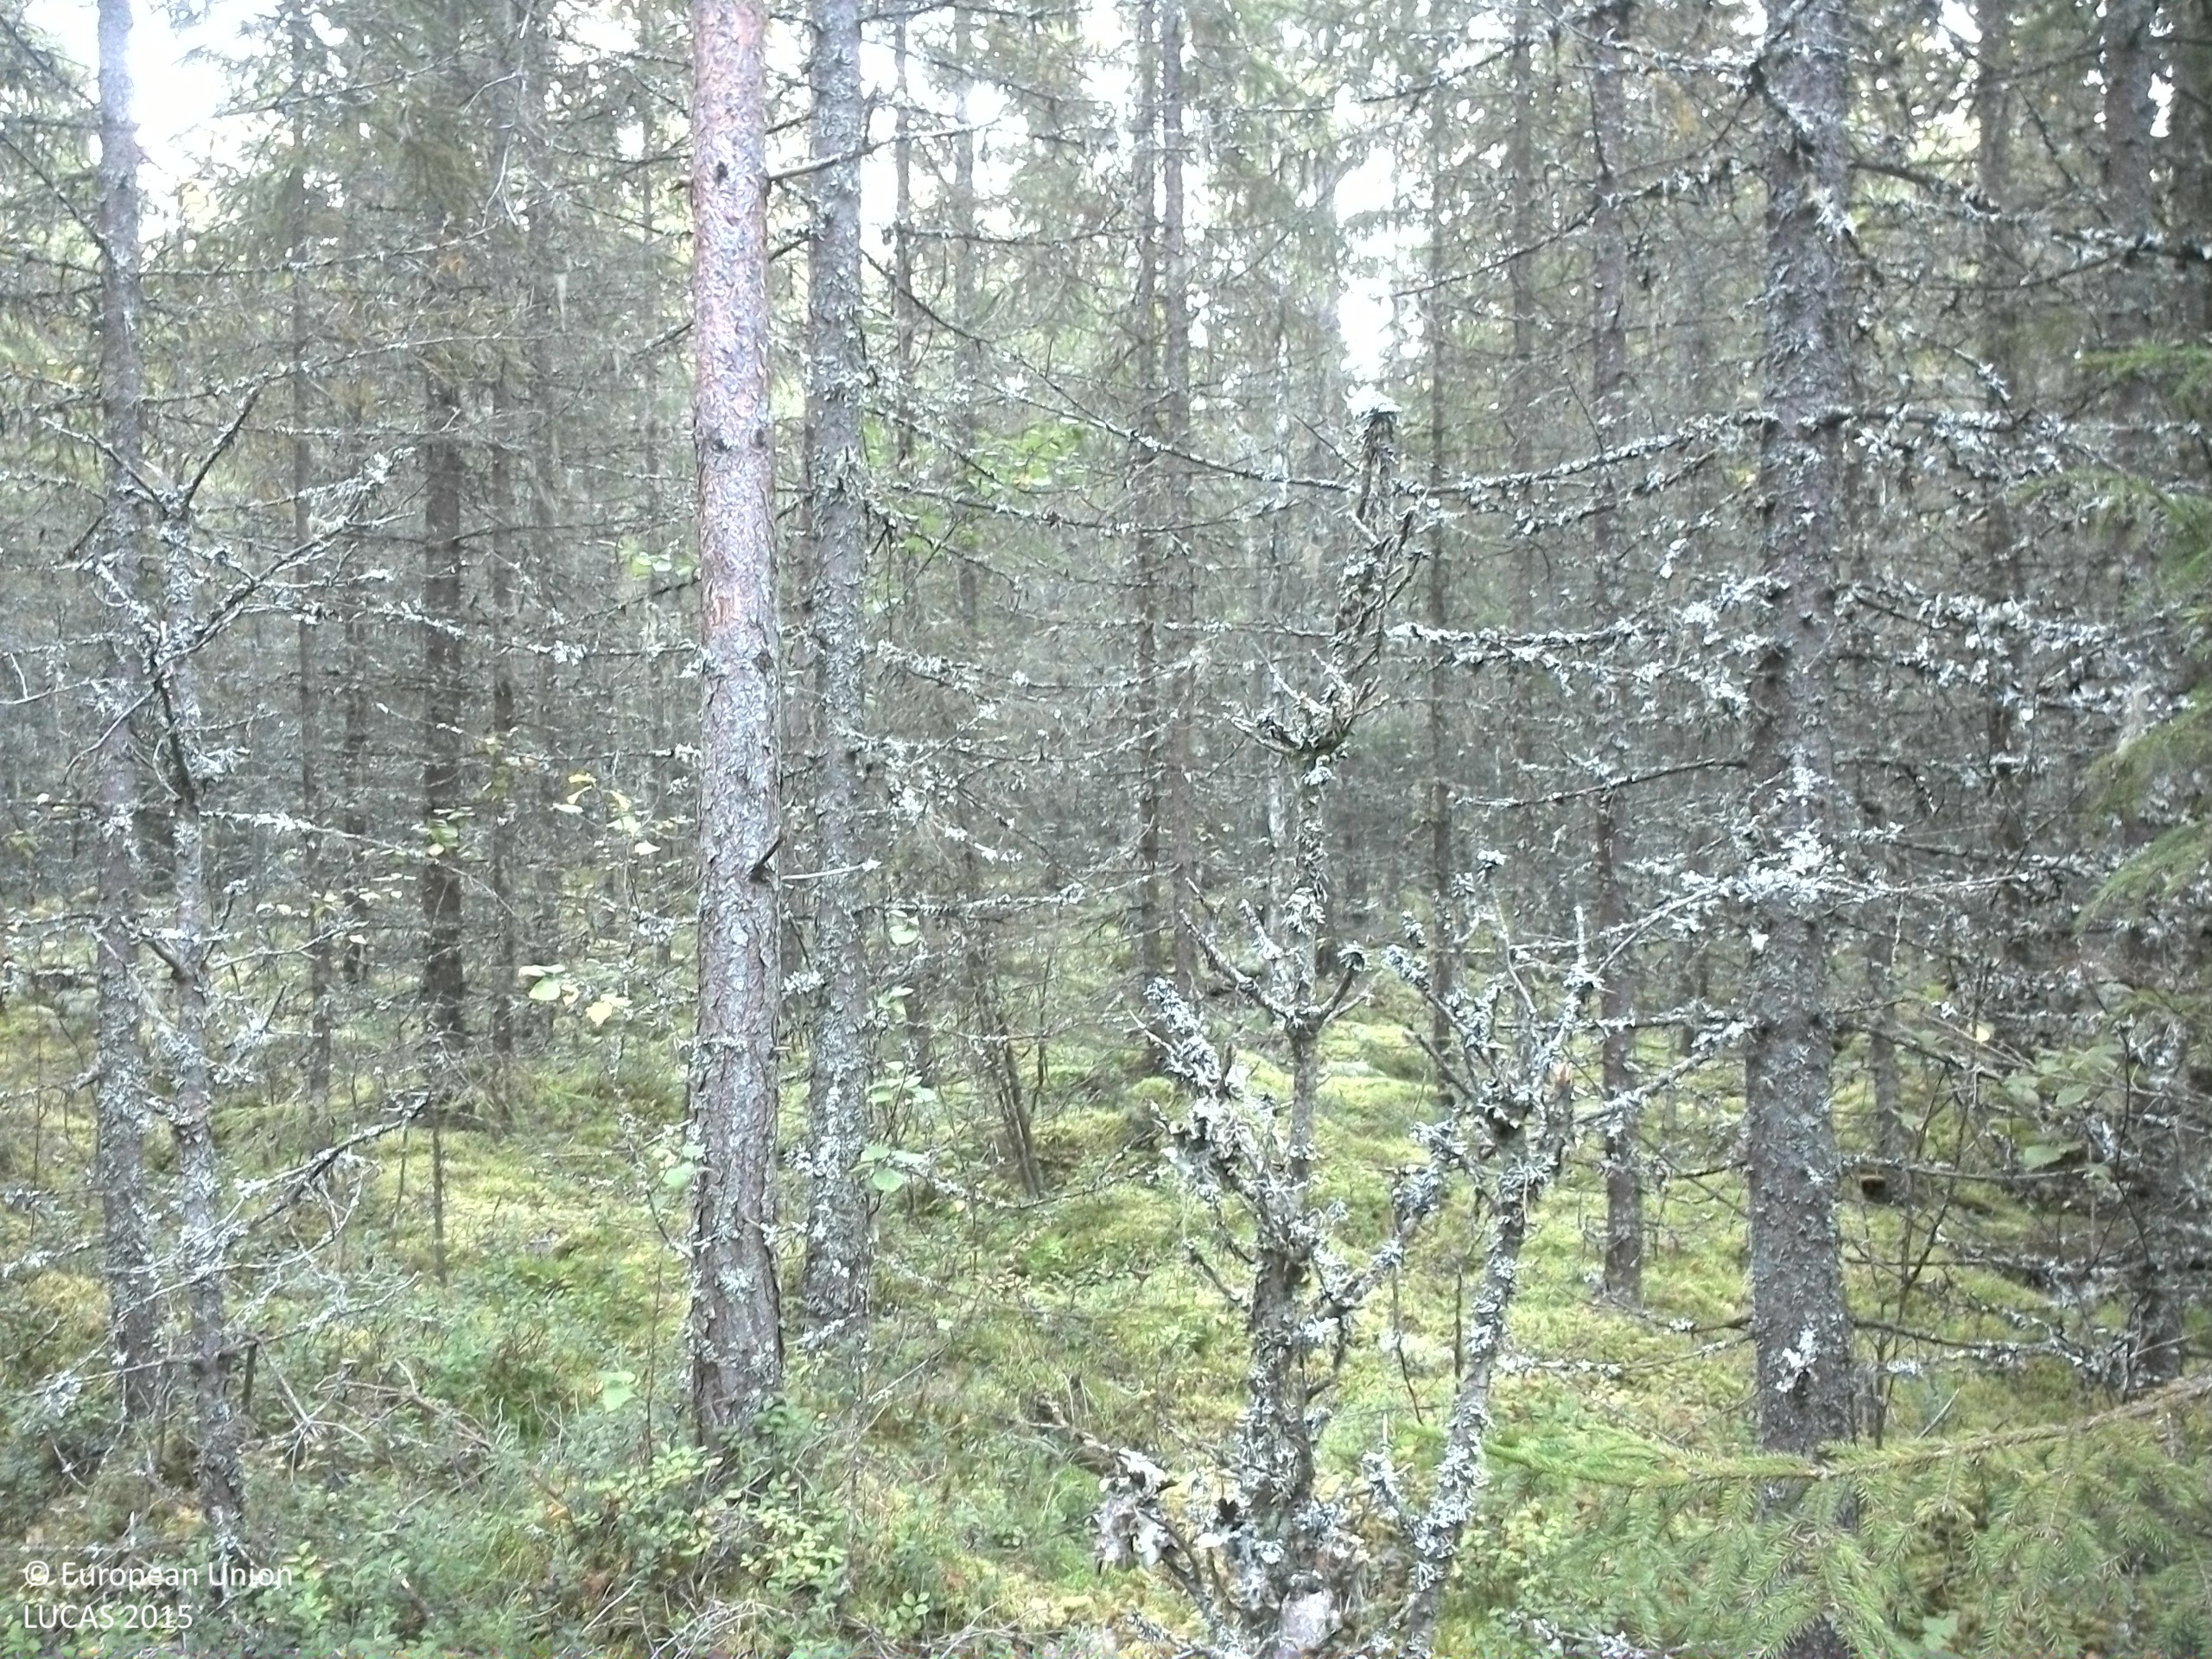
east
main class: Woodland
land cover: Spruce dominated coniferous woodland
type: boreal forest
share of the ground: 50 - 75 %
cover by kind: coniferous forest trees 70 %, shrubs 15 %, lichens and mosses 10 %, broadleaved forest trees 5 %
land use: Forestry
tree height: > 5 m
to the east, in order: Spruce dominated coniferous woodland; Rivers and streams; Spruce dominated coniferous woodland; Spruce dominated mixed woodland
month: September
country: SE
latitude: 59.9036
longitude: 13.4773
